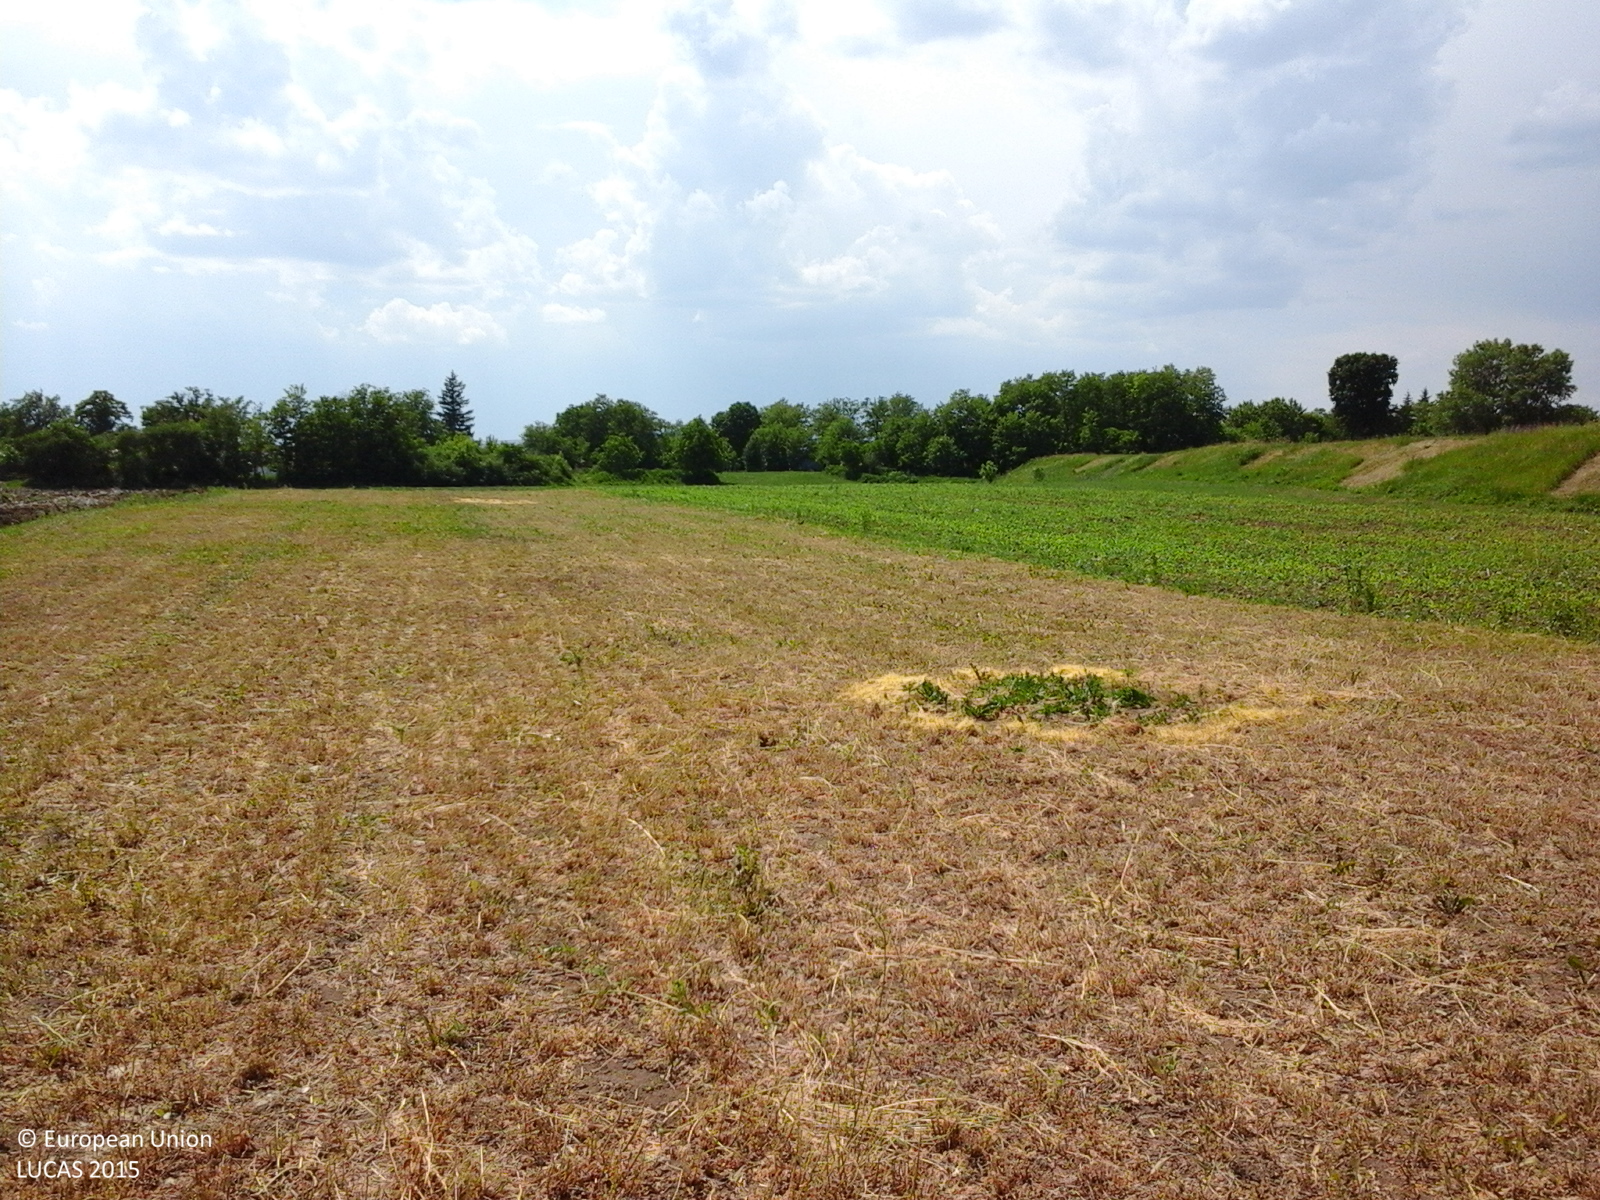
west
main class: Cropland
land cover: Lucerne
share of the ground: 10 - 25 %
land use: Agriculture (excluding fallow land and kitchen gardens)
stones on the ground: < 10 %
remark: Harvested field
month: June
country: RO
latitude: 46.7735
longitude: 26.9241
